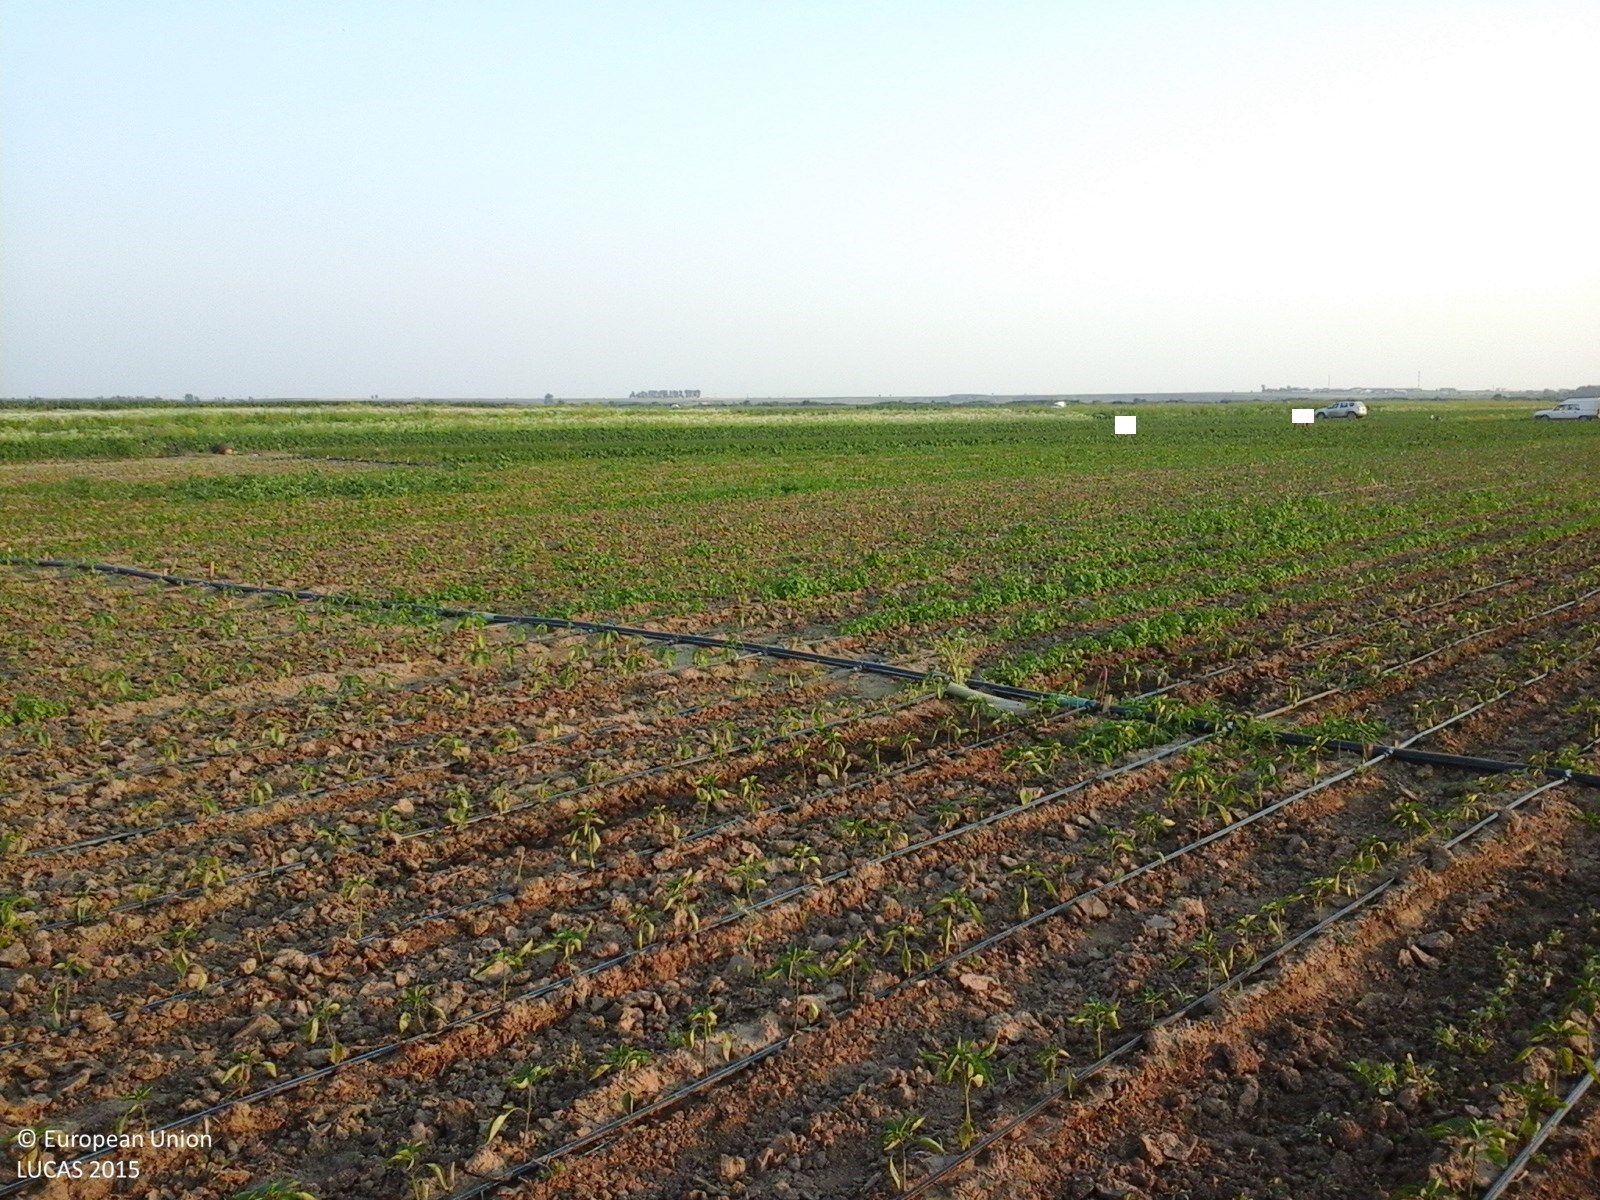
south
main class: Cropland
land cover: Other fresh vegetables
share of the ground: 10 - 25 %
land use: Agriculture (excluding fallow land and kitchen gardens)
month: July
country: RO
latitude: 44.8348
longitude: 25.6964
